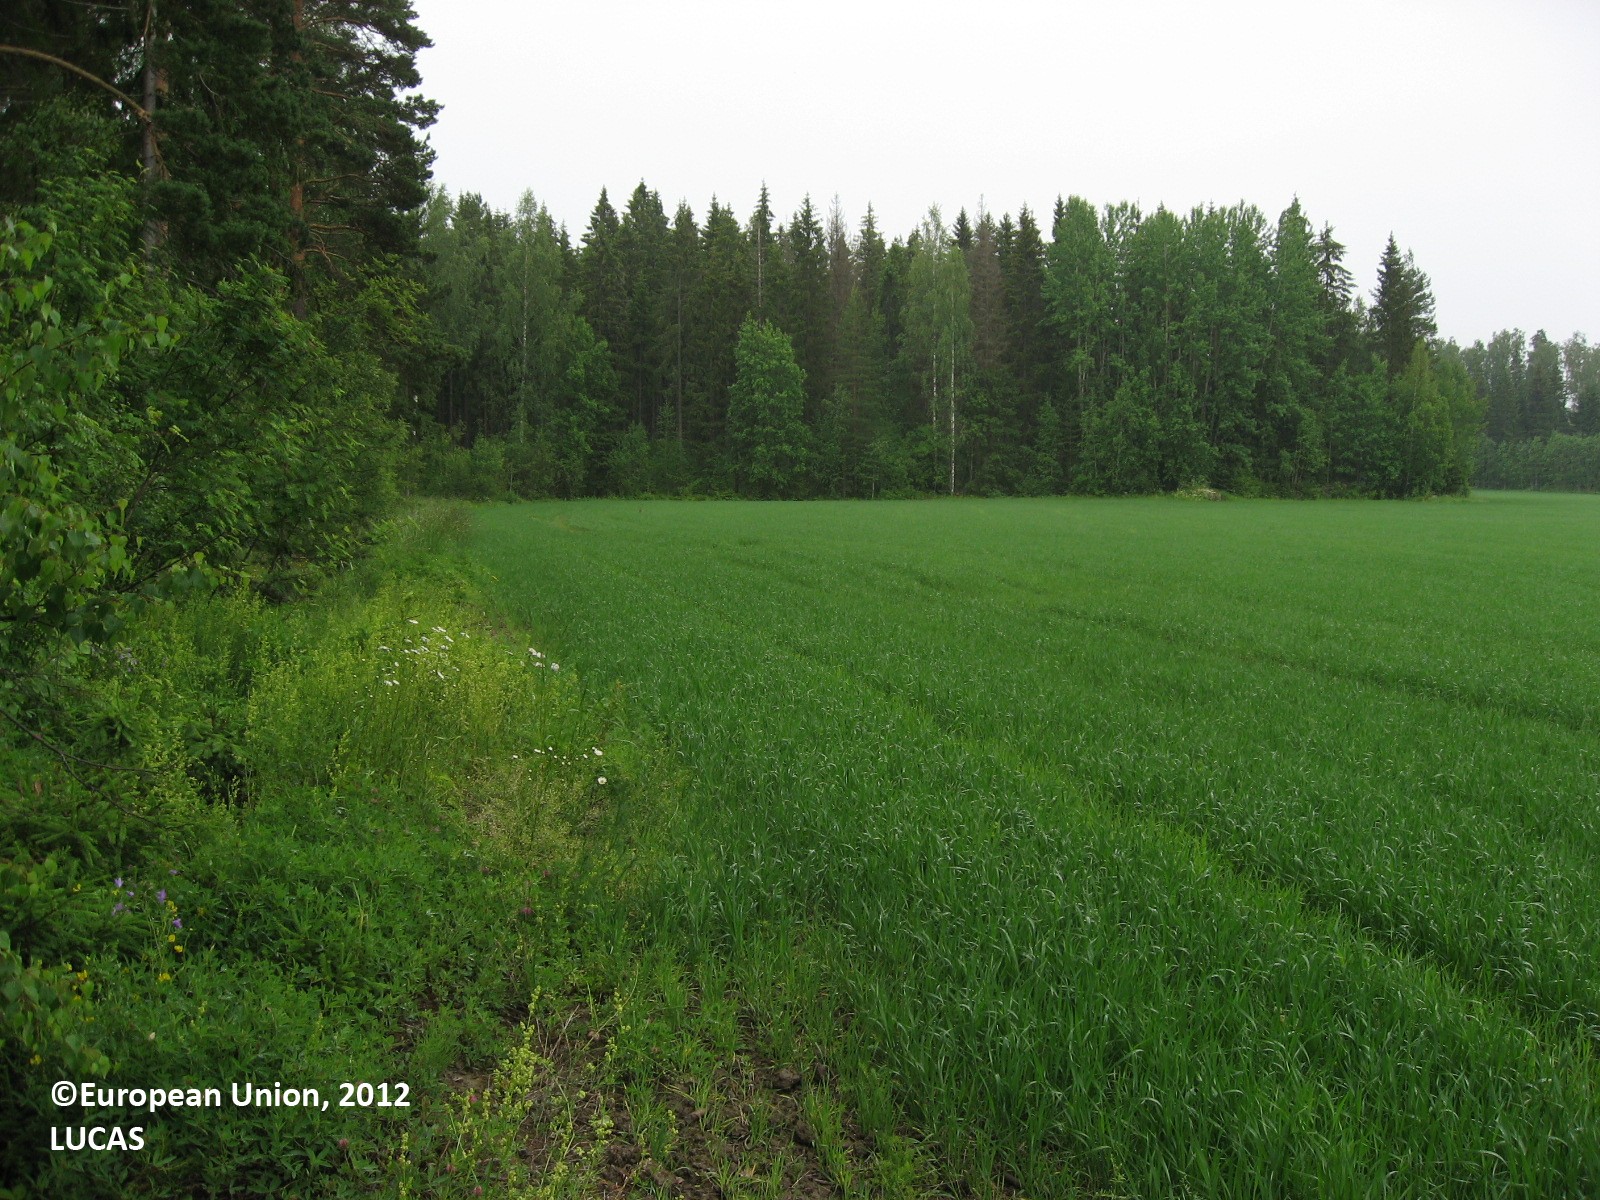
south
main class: Cropland
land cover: Common wheat
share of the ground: > 75 %
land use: Agriculture (excluding fallow land and kitchen gardens)
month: June
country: FI
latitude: 60.5337
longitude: 26.1282
